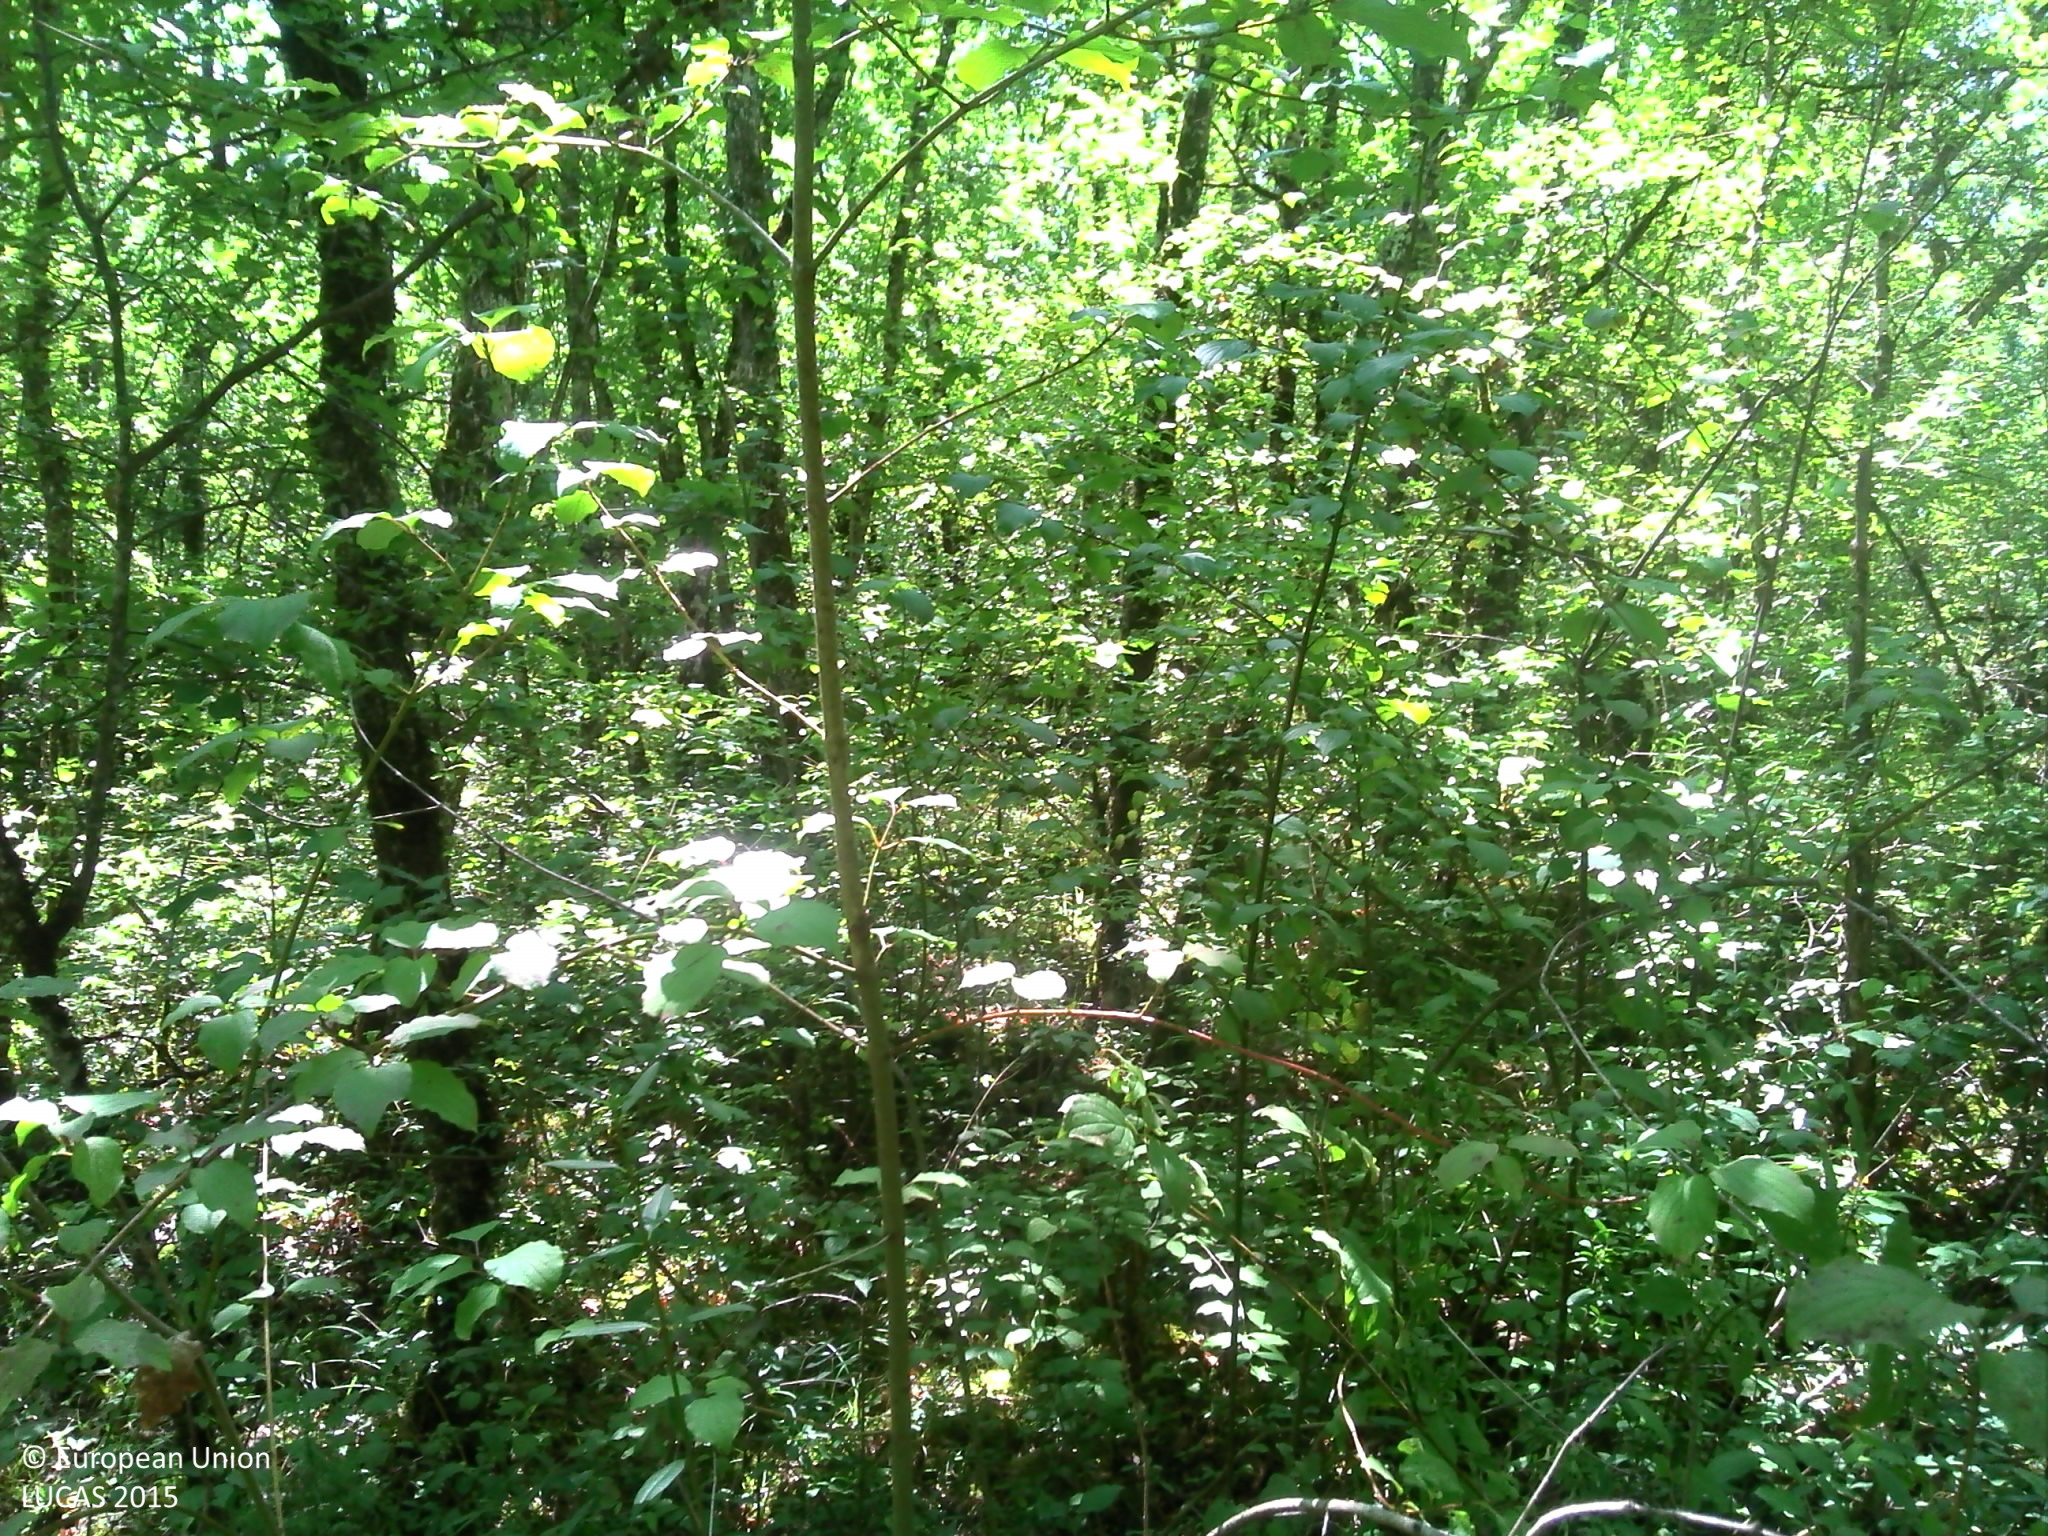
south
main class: Woodland
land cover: Broadleaved woodland
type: thermophilous deciduous forest
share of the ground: > 75 %
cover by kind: broadleaved forest trees 60 %, shrubs 25 %, herbaceous plants 10 %, lichens and mosses 5 %
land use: Forestry
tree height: > 5 m
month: August
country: FR
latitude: 44.2848
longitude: 1.6418
